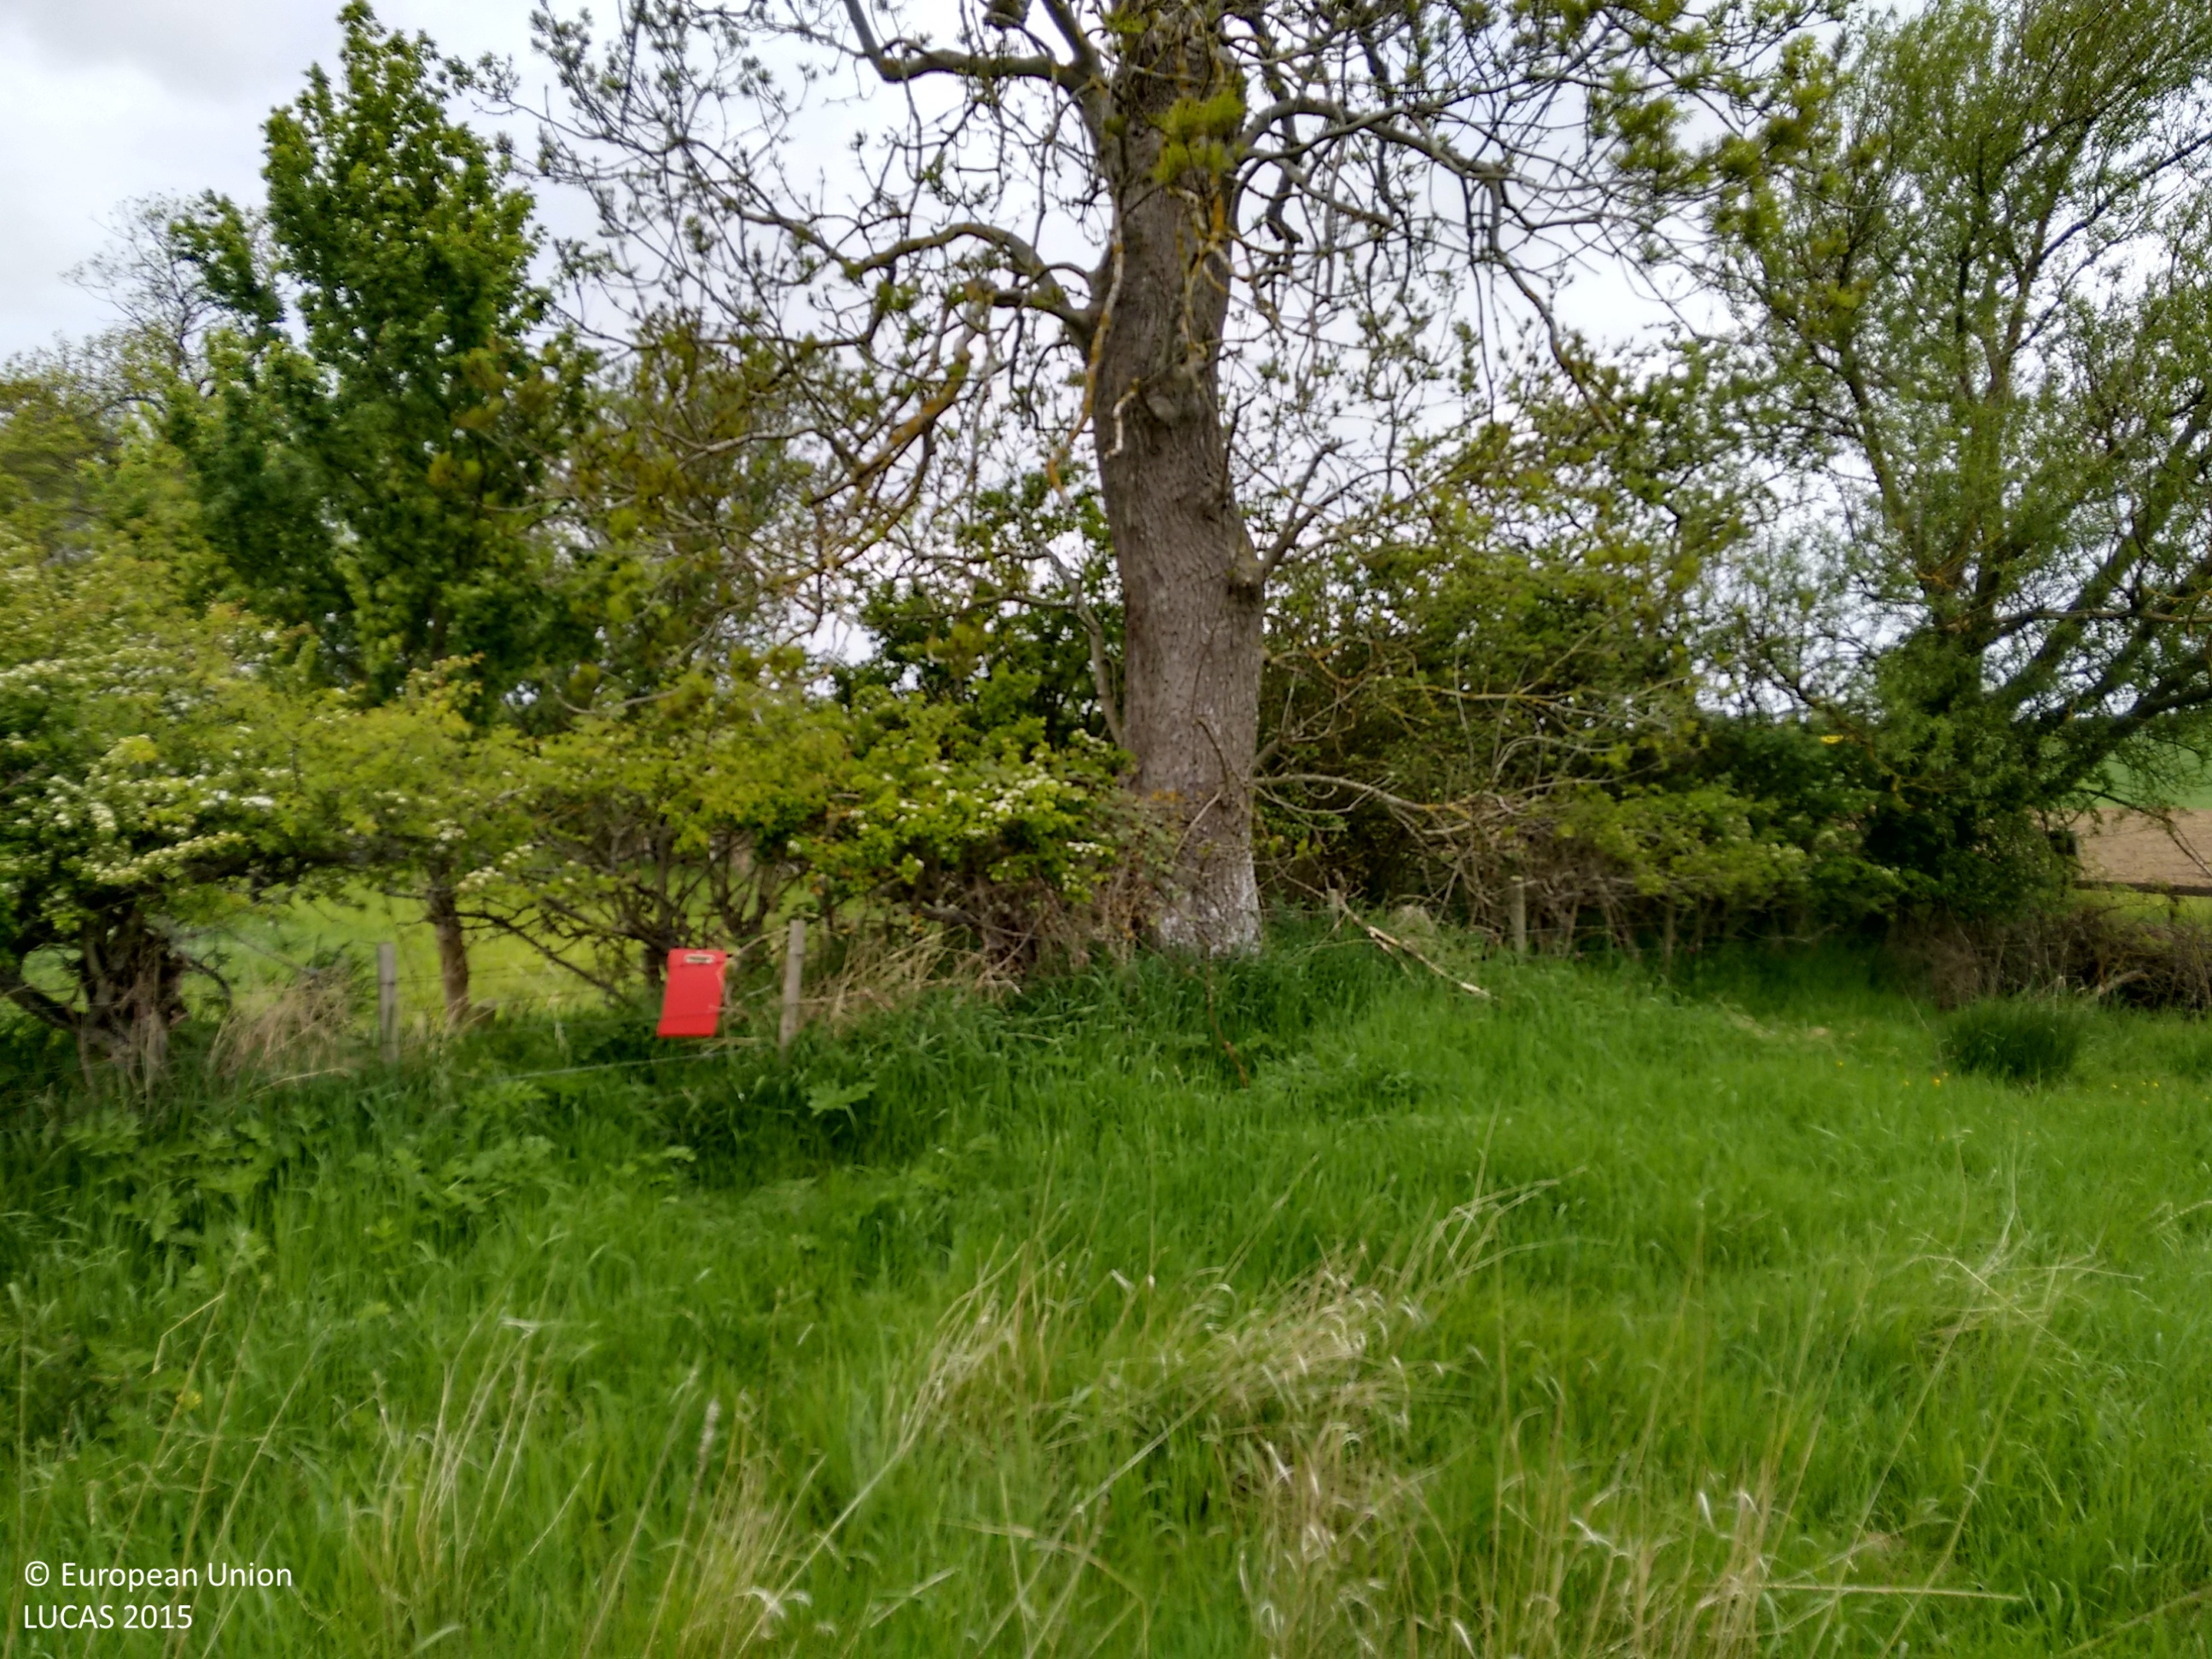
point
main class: Grassland
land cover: Grassland without tree/shrub cover
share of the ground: > 75 %
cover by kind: herbaceous plants 100 %
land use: Agriculture (excluding fallow land and kitchen gardens)
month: May
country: GB
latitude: 55.7743
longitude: -2.1220
